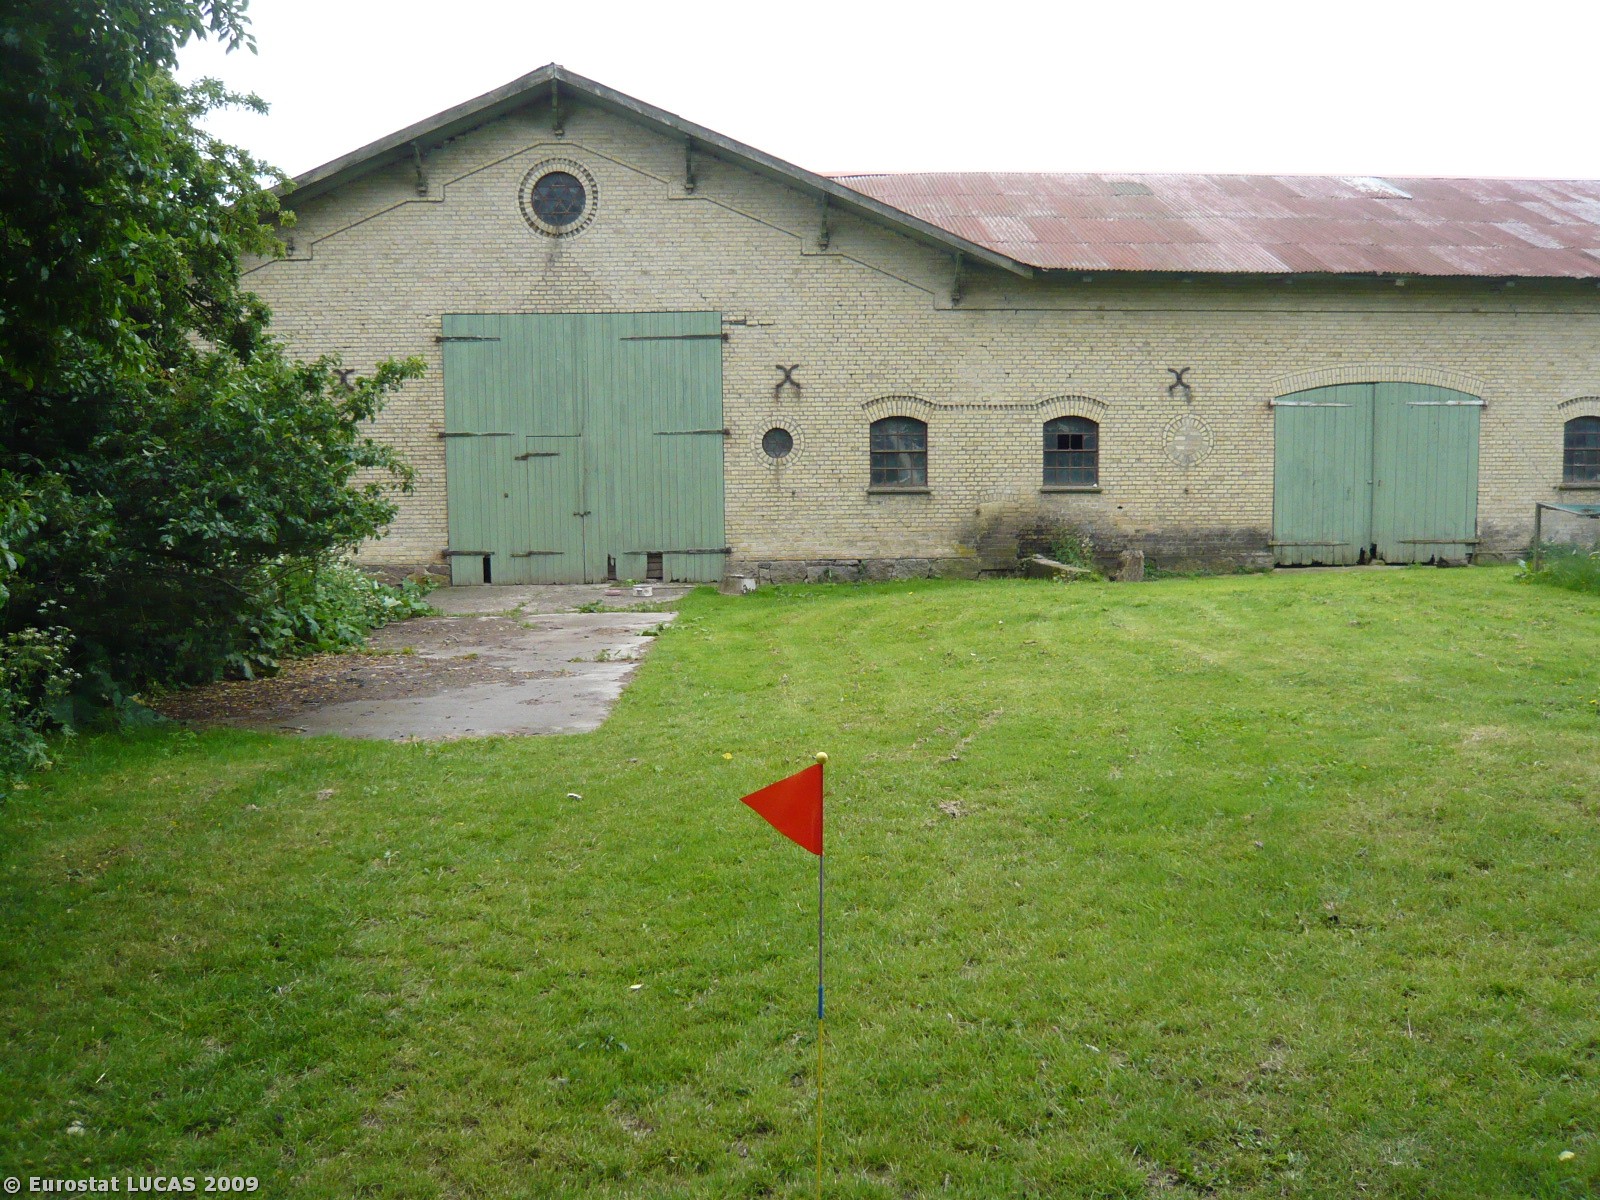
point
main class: Grassland
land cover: Grassland without tree/shrub cover
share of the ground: > 75 %
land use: Agriculture (excluding fallow land and kitchen gardens)
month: June
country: DK
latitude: 54.9323
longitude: 11.9496
